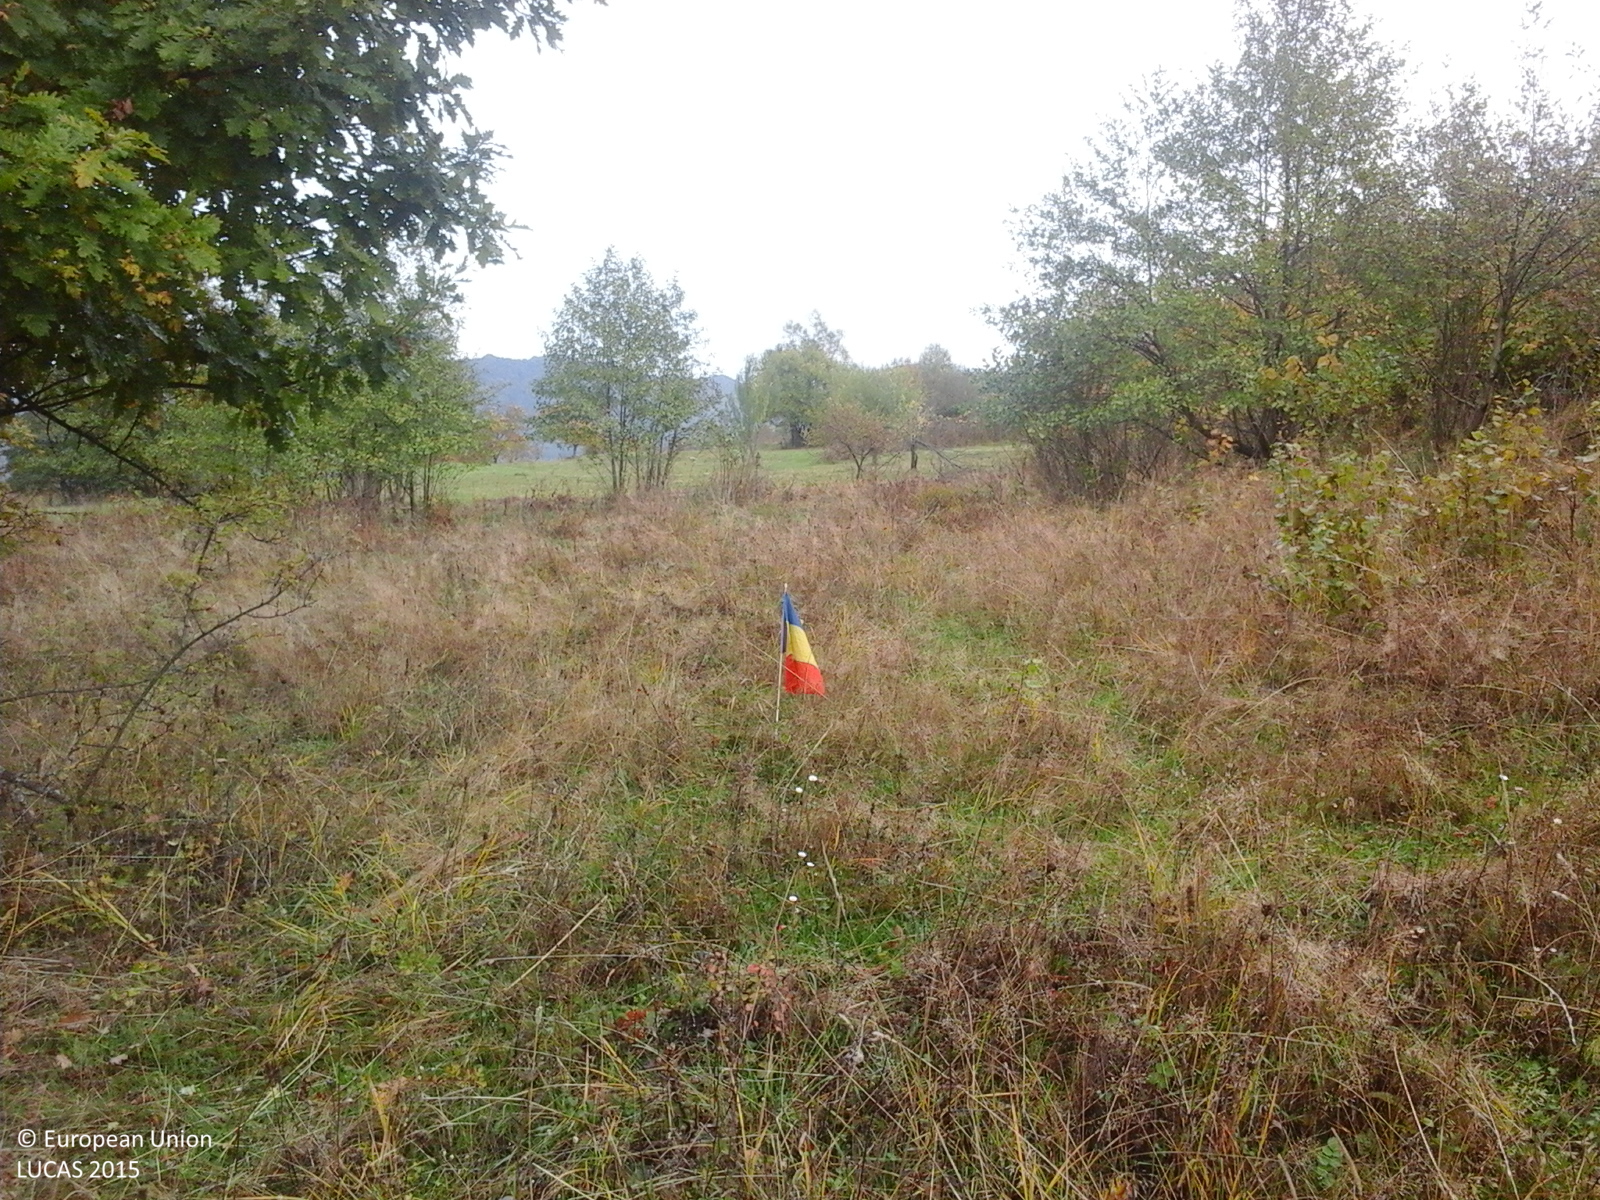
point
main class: Grassland
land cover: Grassland with sparse tree/shrub cover
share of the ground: > 75 %
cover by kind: herbaceous plants 85 %, shrubs 10 %, broadleaved forest trees 5 %
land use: Agriculture (excluding fallow land and kitchen gardens)
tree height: > 5 m
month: October
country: RO
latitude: 46.9327
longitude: 24.8742
